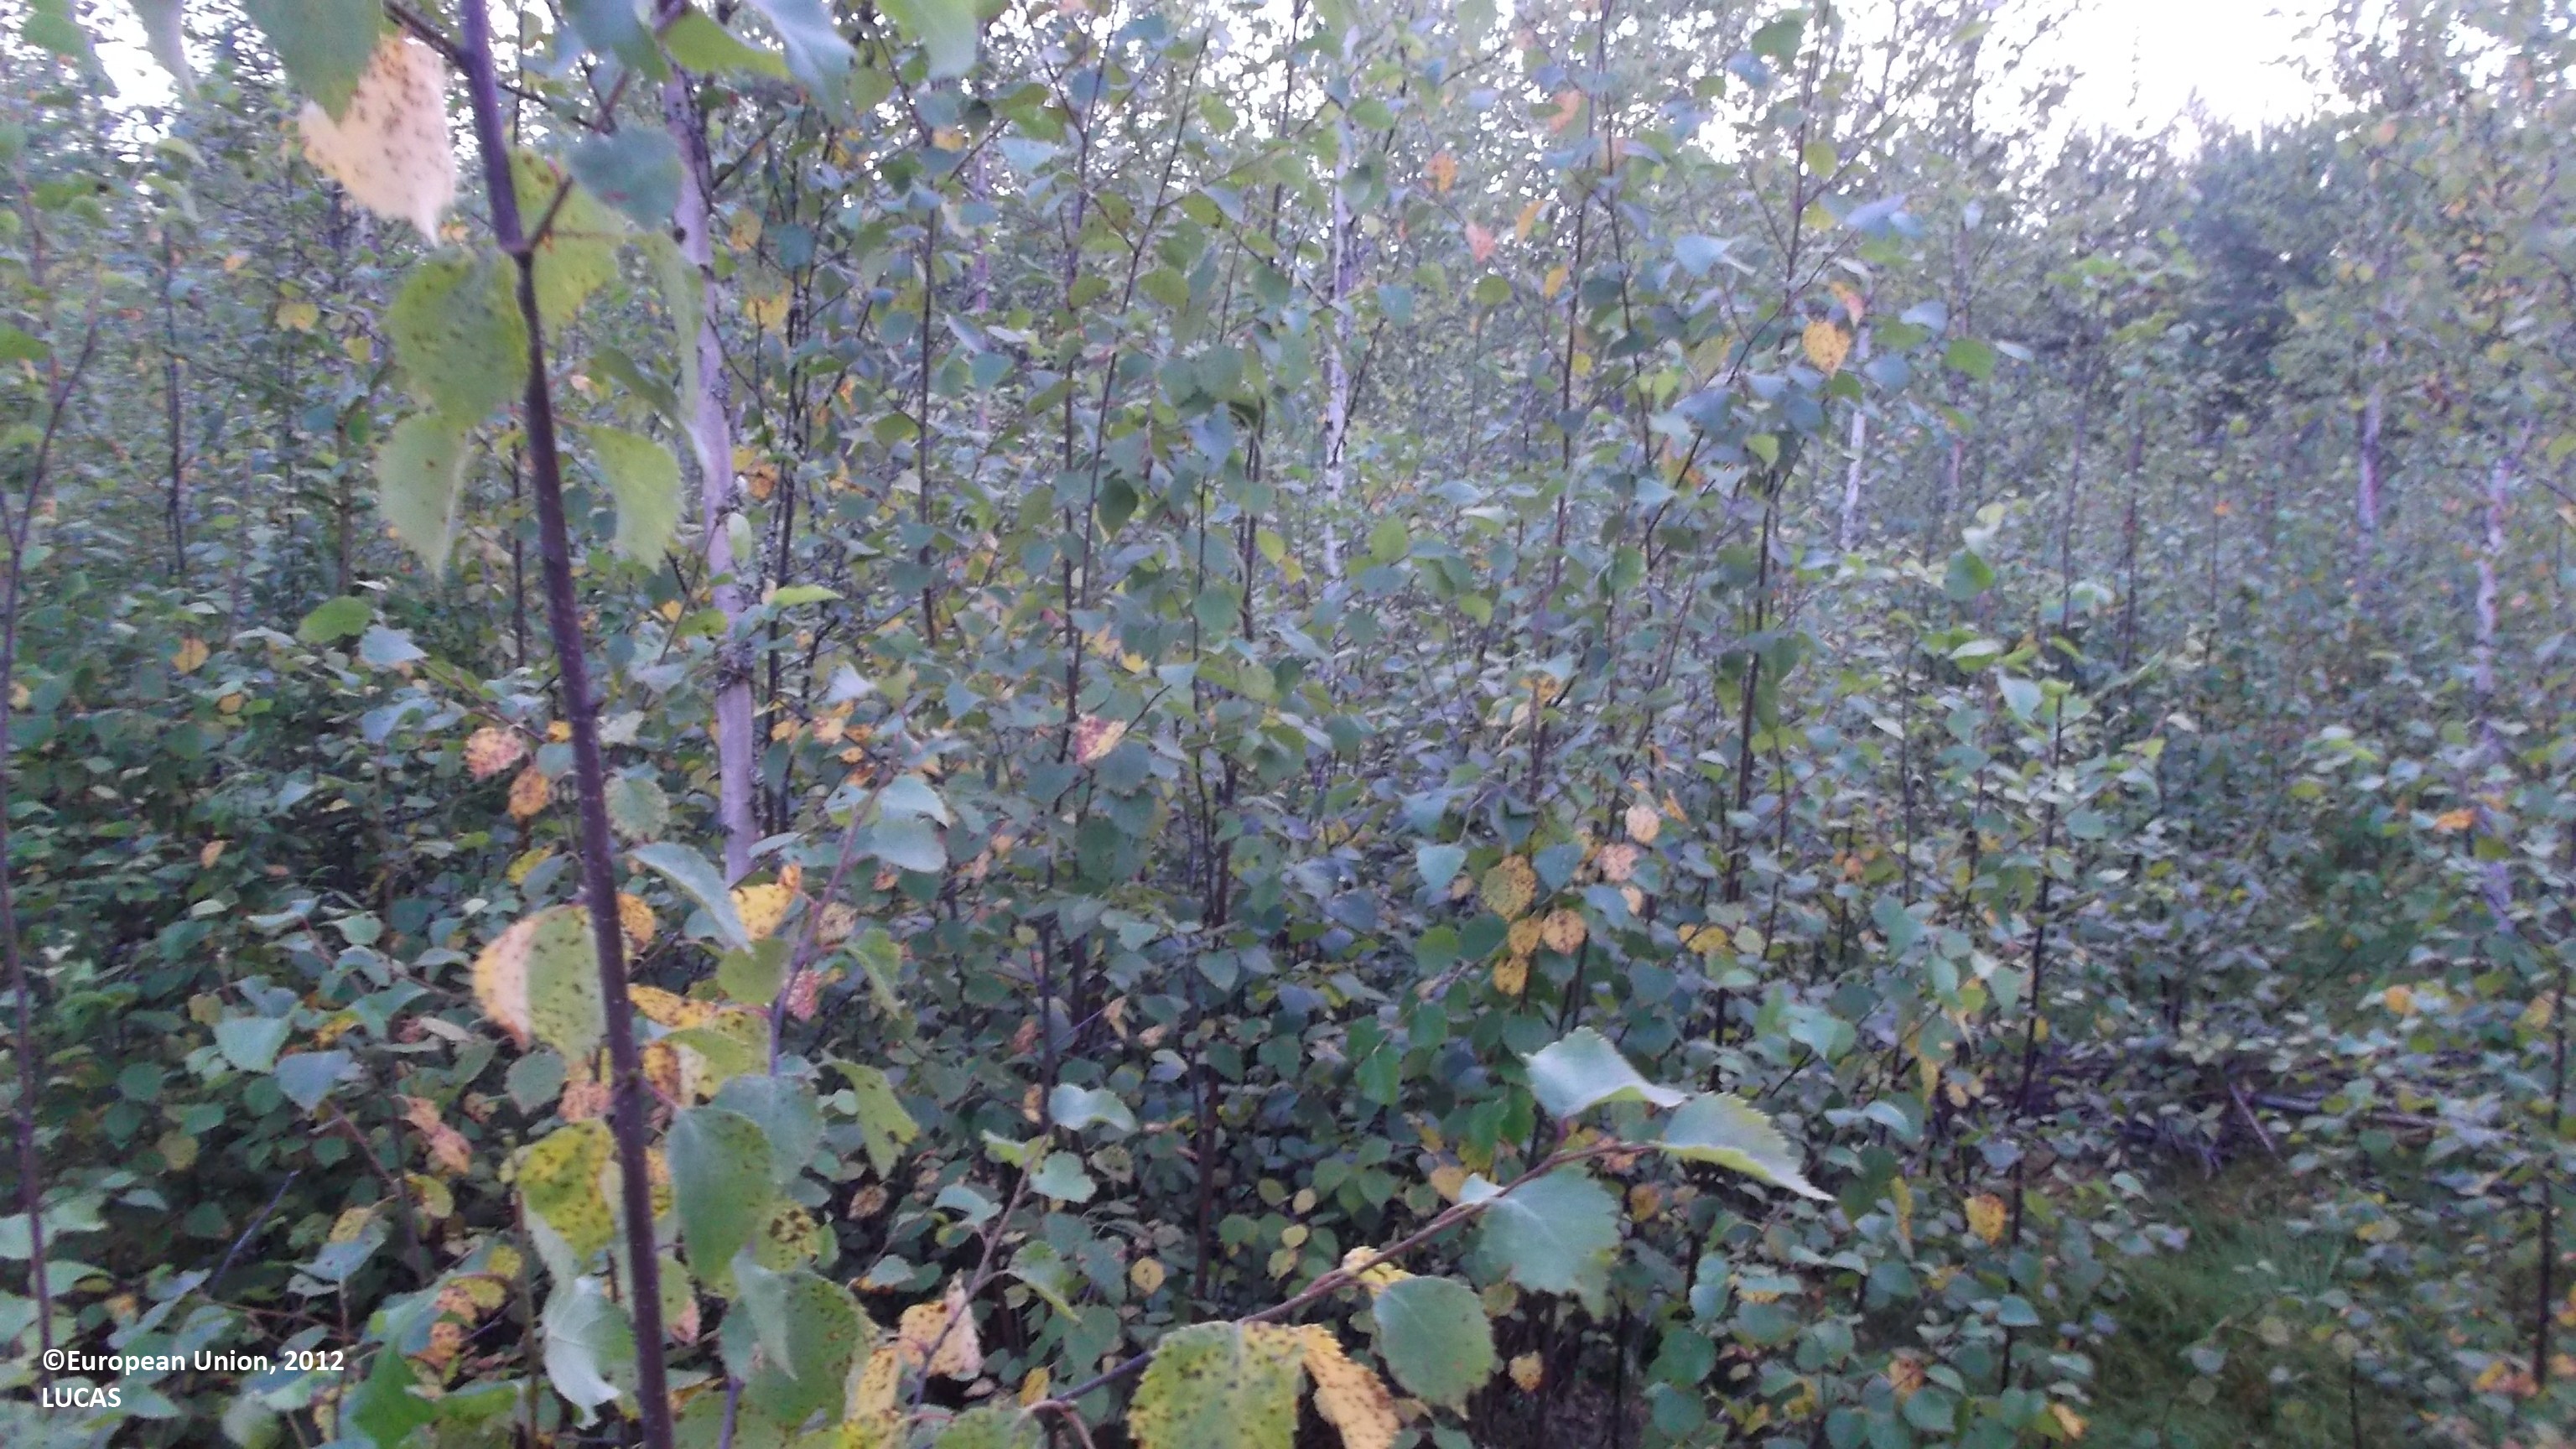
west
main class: Woodland
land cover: Broadleaved woodland
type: boreal forest
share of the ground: 25 - 50 %
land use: Forestry
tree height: < 5 m
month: August
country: FI
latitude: 63.0757
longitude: 23.7887
